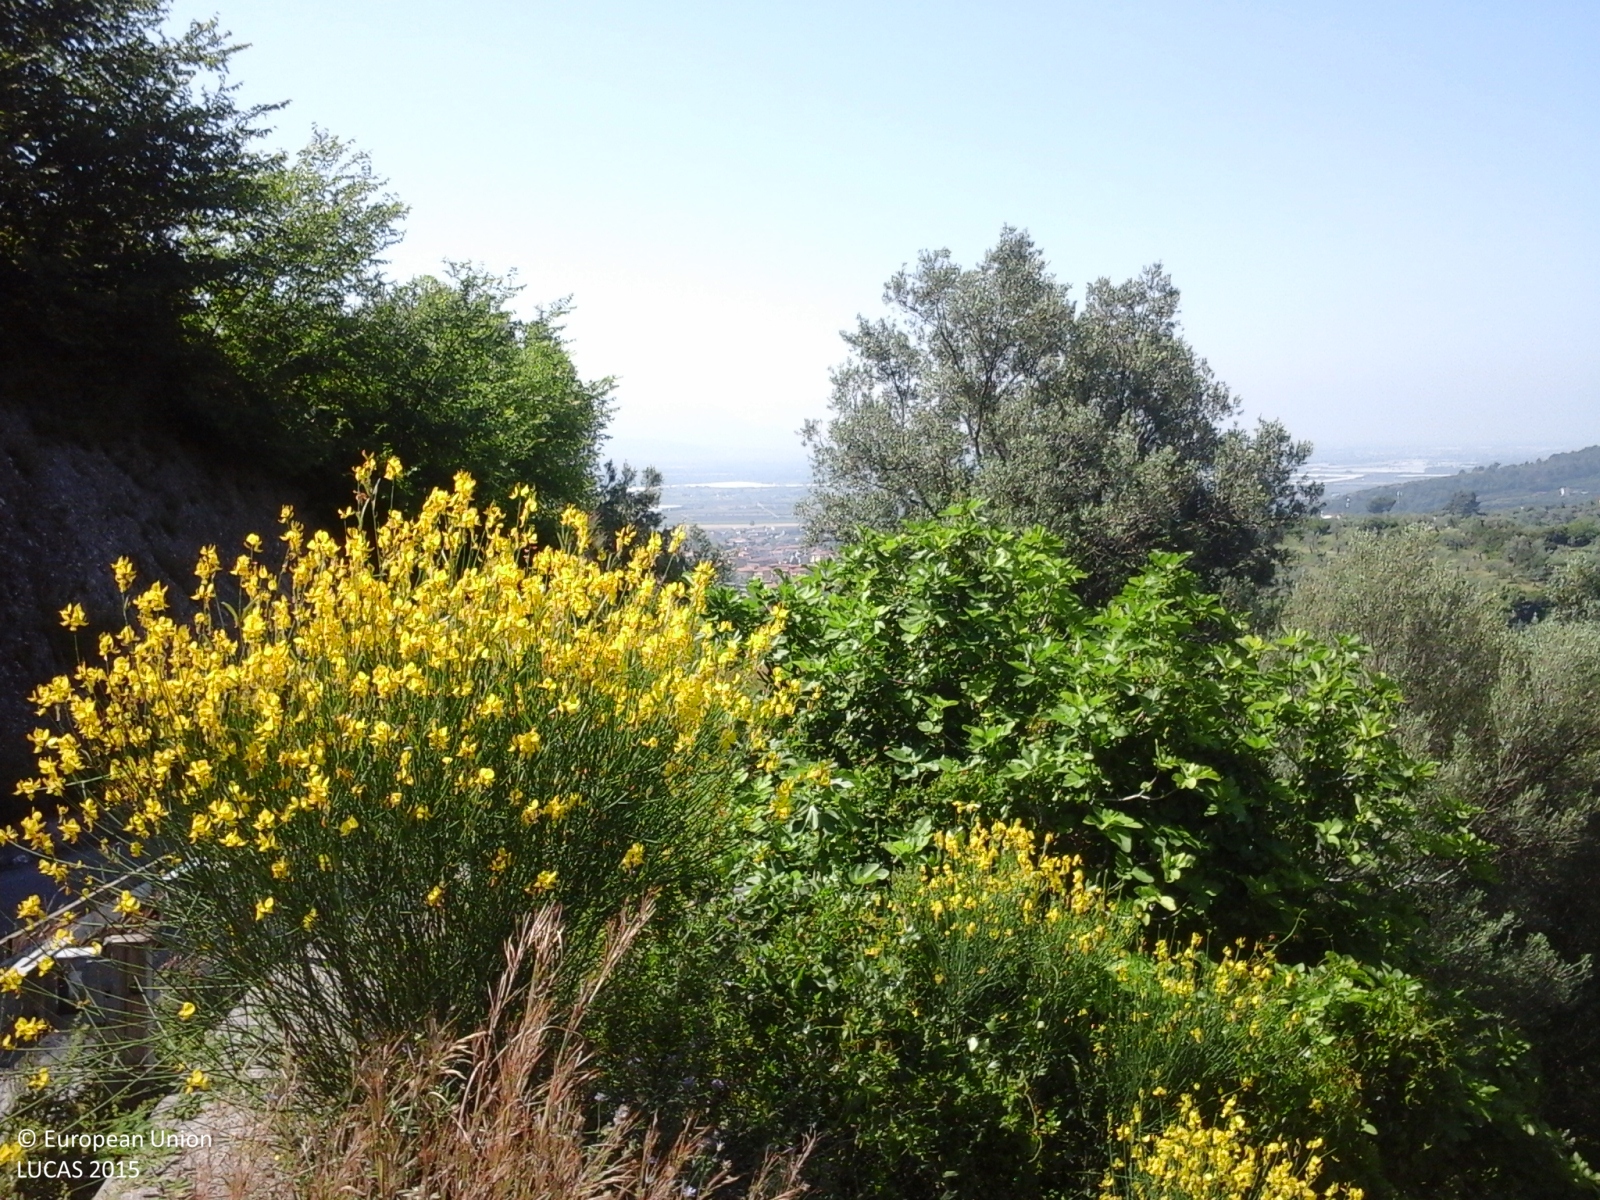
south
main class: Cropland
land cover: Olive groves
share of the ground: 50 - 75 %
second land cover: Grassland without tree/shrub cover
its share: 50 - 75 %
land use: Abandoned areas
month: June
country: IT
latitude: 40.6267
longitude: 15.0508
